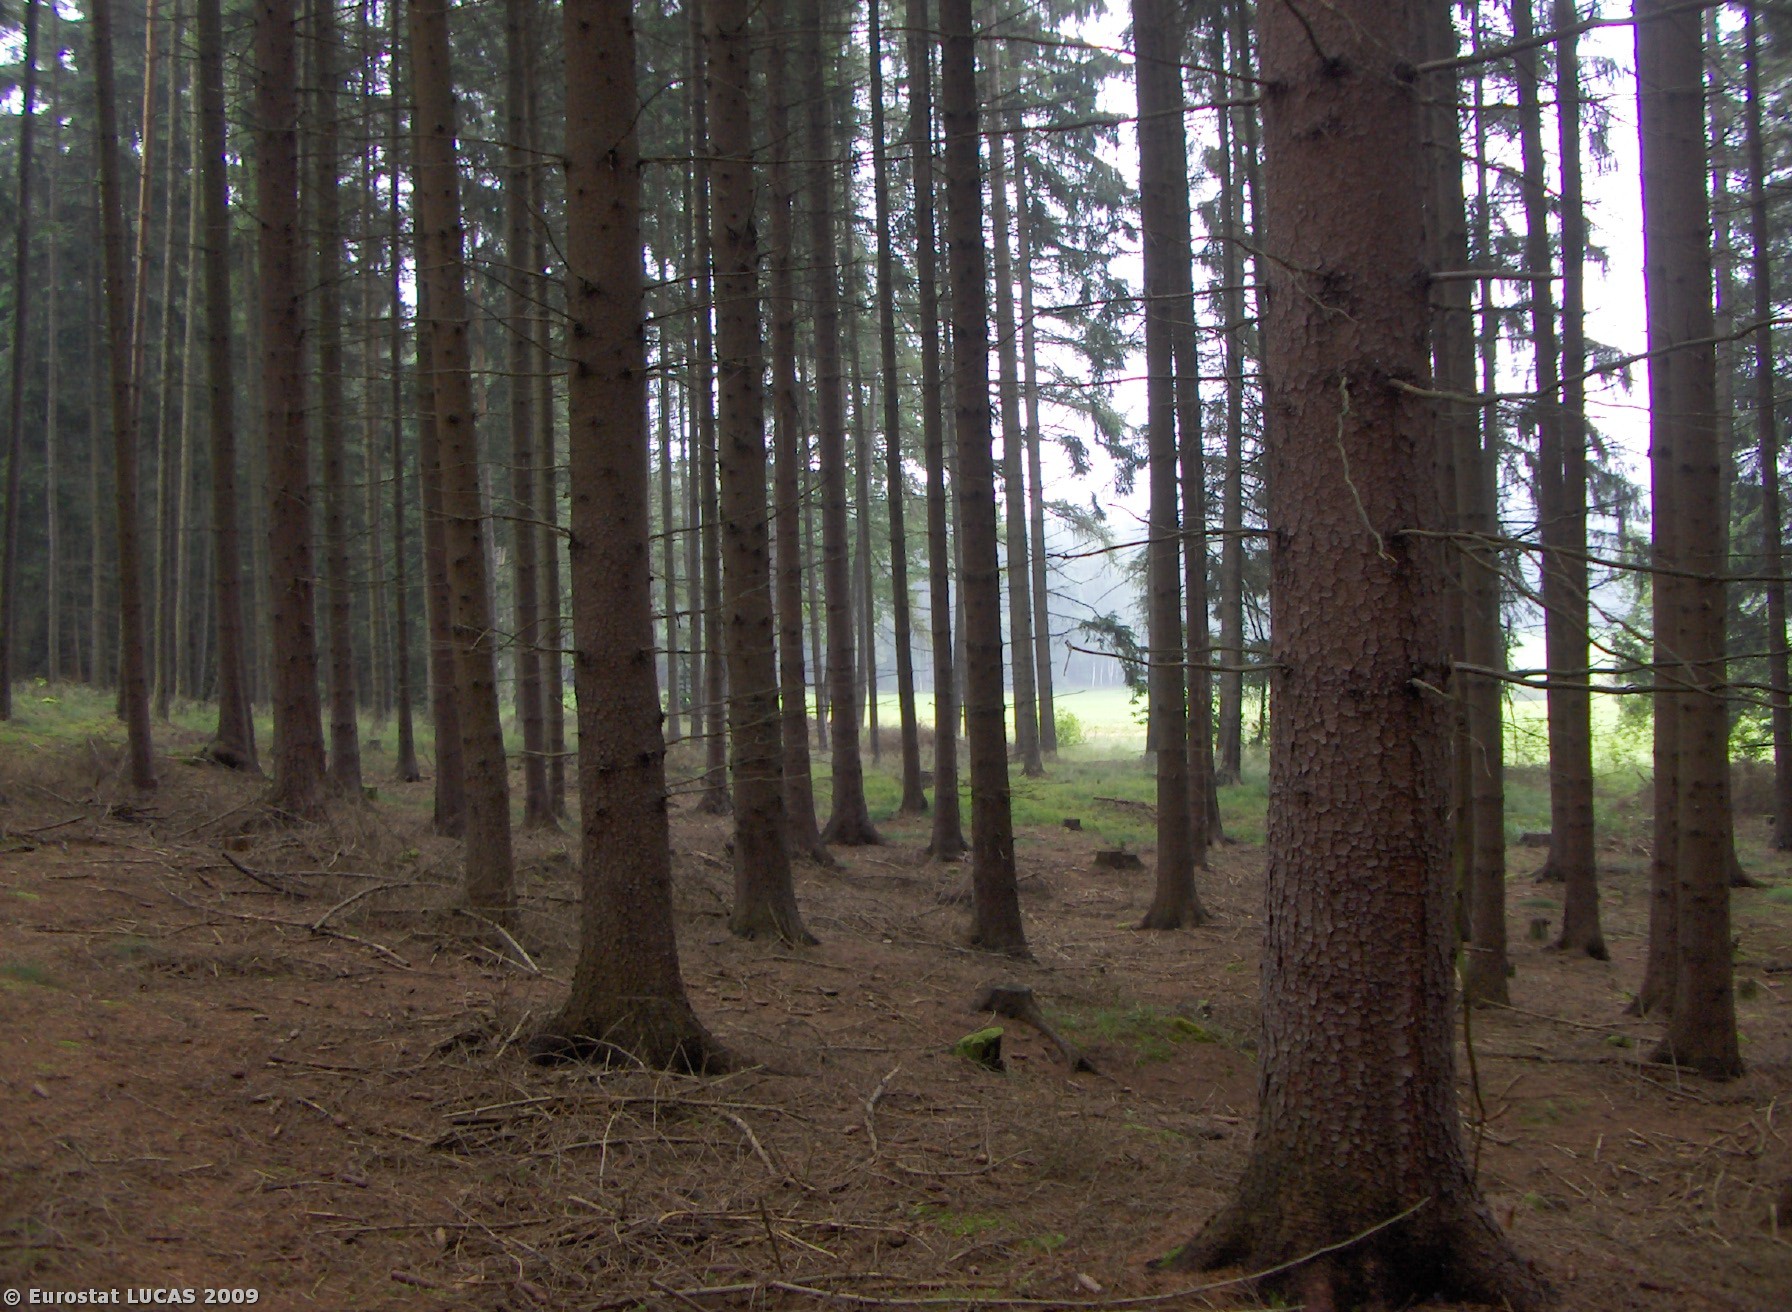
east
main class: Woodland
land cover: Coniferous woodland
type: hemiboreal forest and nemoral coniferous forest and mixed broadleaved-coniferous forest
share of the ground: > 75 %
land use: Forestry
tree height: > 5 m
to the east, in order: Coniferous woodland; Tracks; Mixed woodland; Grassland without tree/shrub cover; Coniferous woodland
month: July
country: CZ
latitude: 49.4101
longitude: 12.8803
